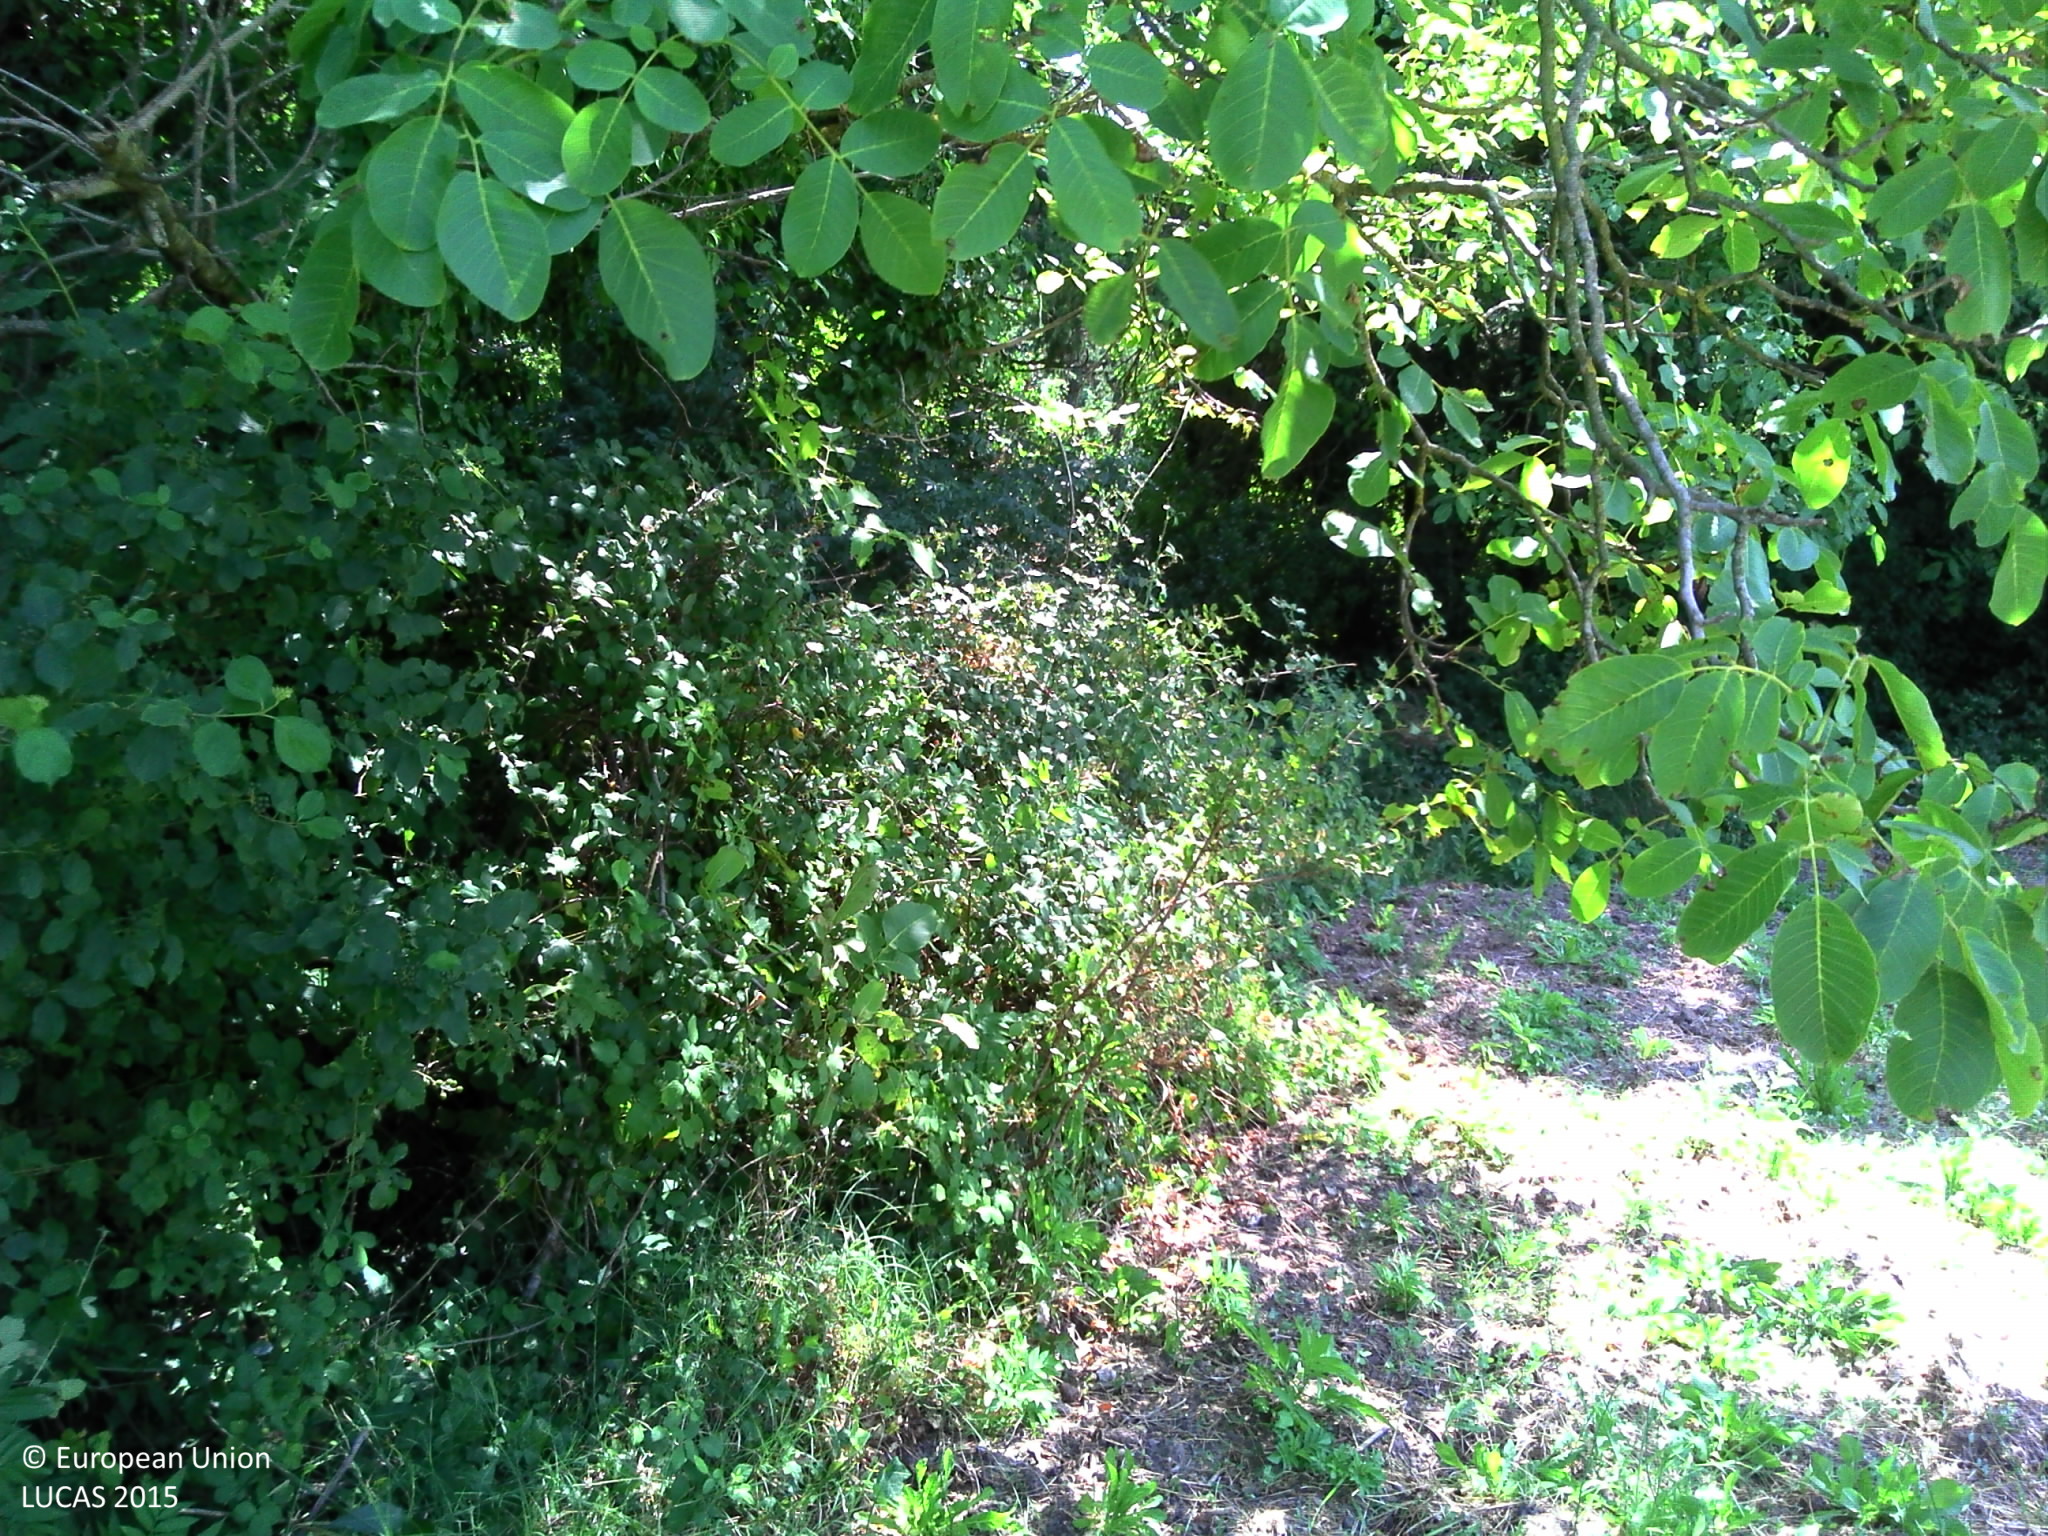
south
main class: Grassland
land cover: Grassland without tree/shrub cover
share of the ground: > 75 %
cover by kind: herbaceous plants 100 %
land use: Agriculture (excluding fallow land and kitchen gardens)
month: July
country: FR
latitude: 44.0507
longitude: 5.0282
